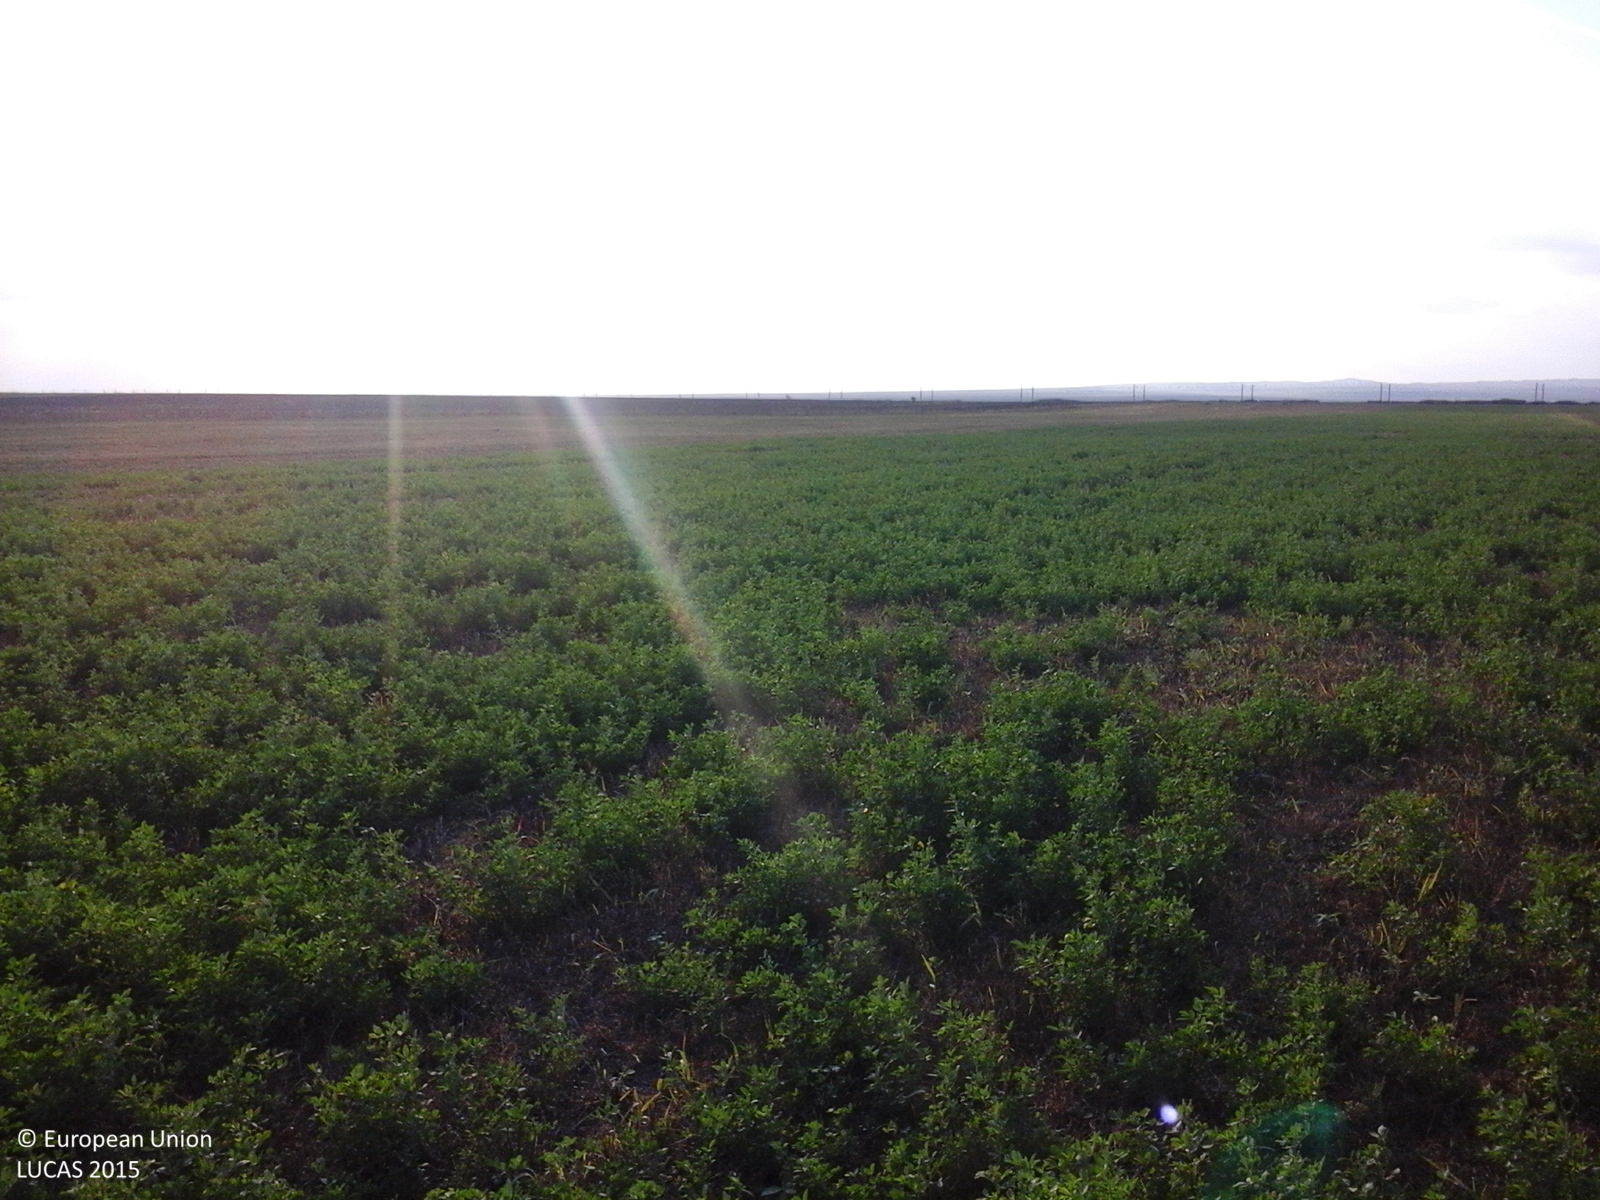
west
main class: Cropland
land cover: Lucerne
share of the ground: > 75 %
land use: Agriculture (excluding fallow land and kitchen gardens)
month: October
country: RO
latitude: 45.3201
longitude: 27.0417
